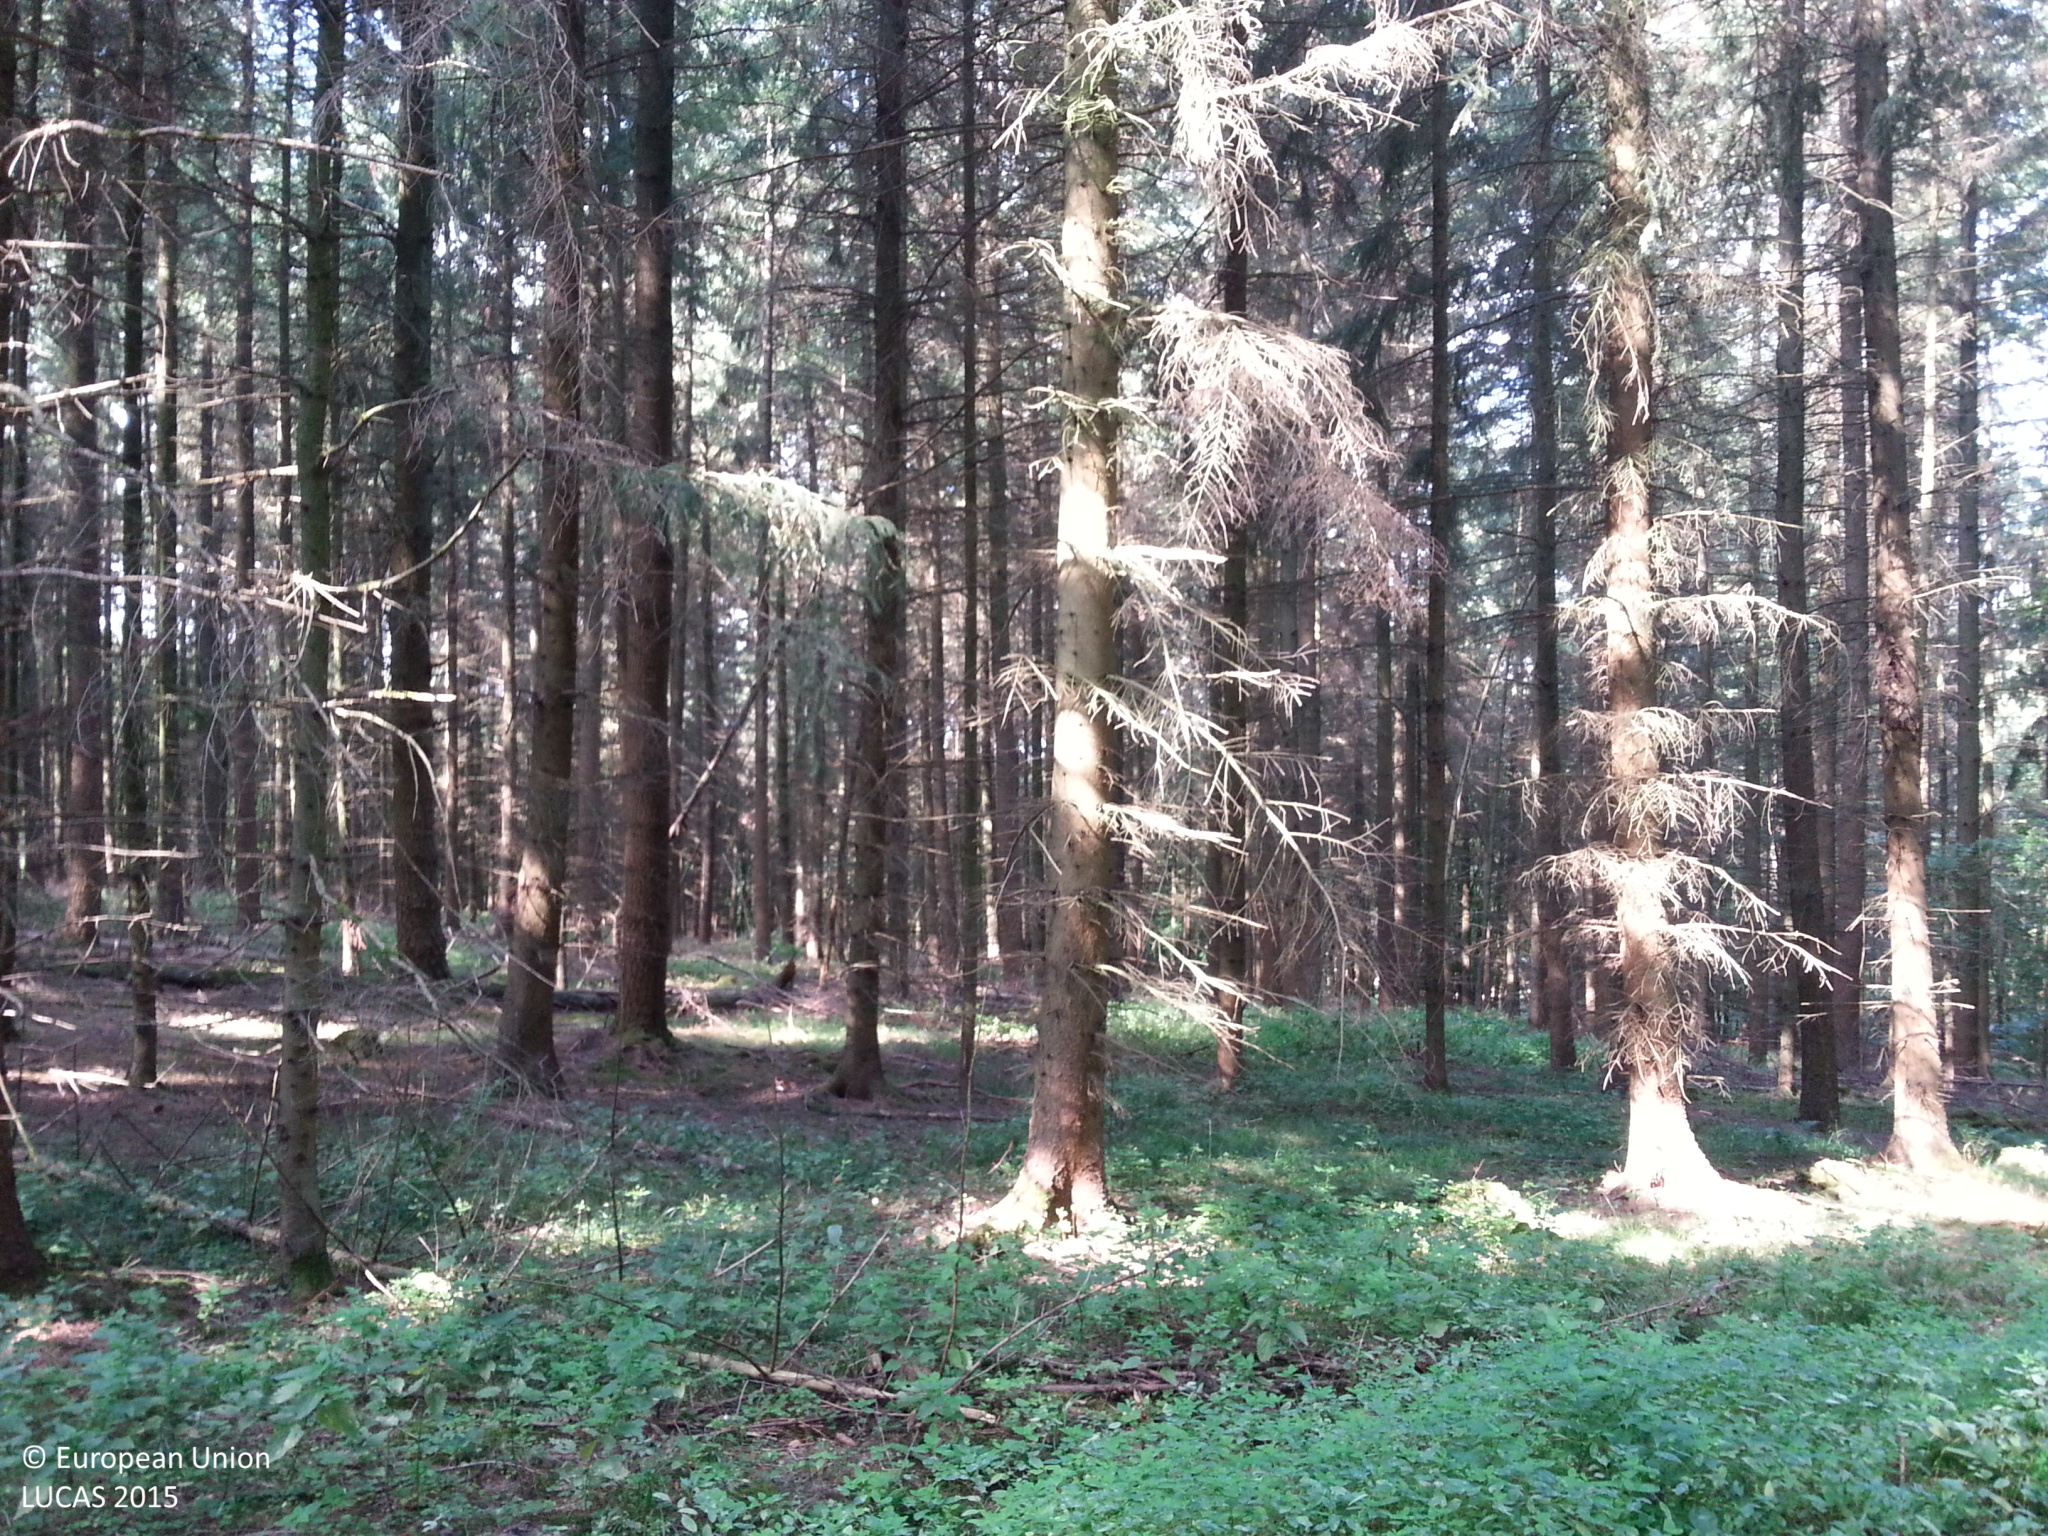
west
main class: Woodland
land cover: Spruce dominated coniferous woodland
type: boreal forest
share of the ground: > 75 %
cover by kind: coniferous forest trees 80 %, herbaceous plants 10 %, lichens and mosses 10 %
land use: Forestry
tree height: > 5 m
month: September
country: DE
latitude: 49.3554
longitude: 9.4082
